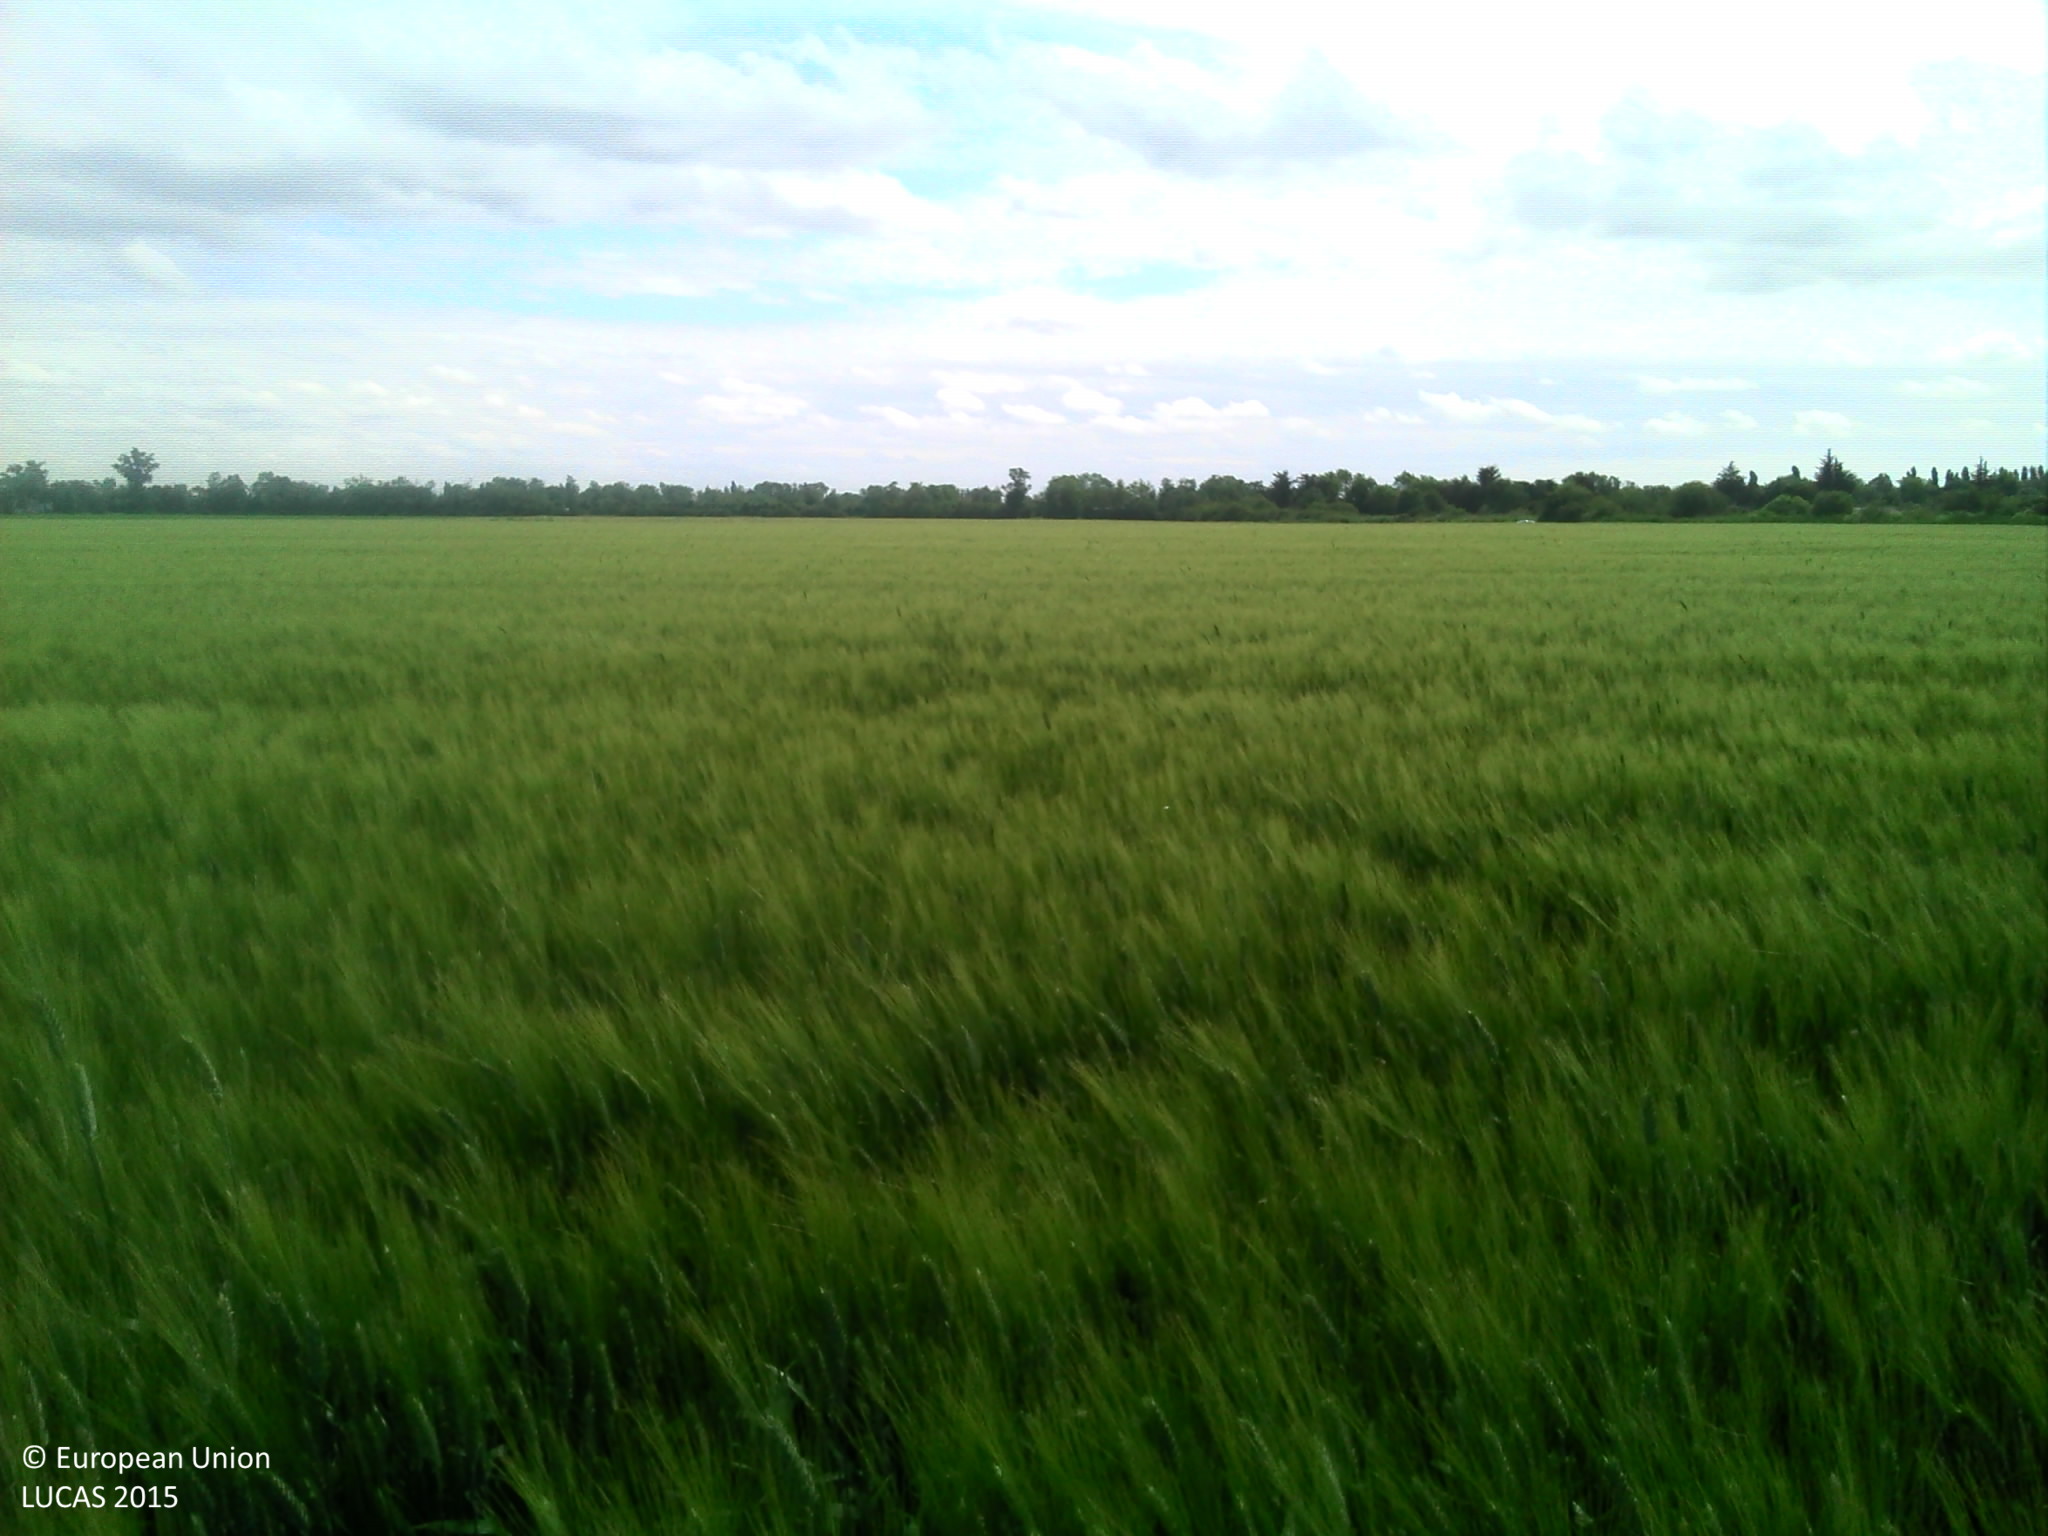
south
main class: Cropland
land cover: Durum wheat
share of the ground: > 75 %
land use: Agriculture (excluding fallow land and kitchen gardens)
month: June
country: FR
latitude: 46.3291
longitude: -0.9811
